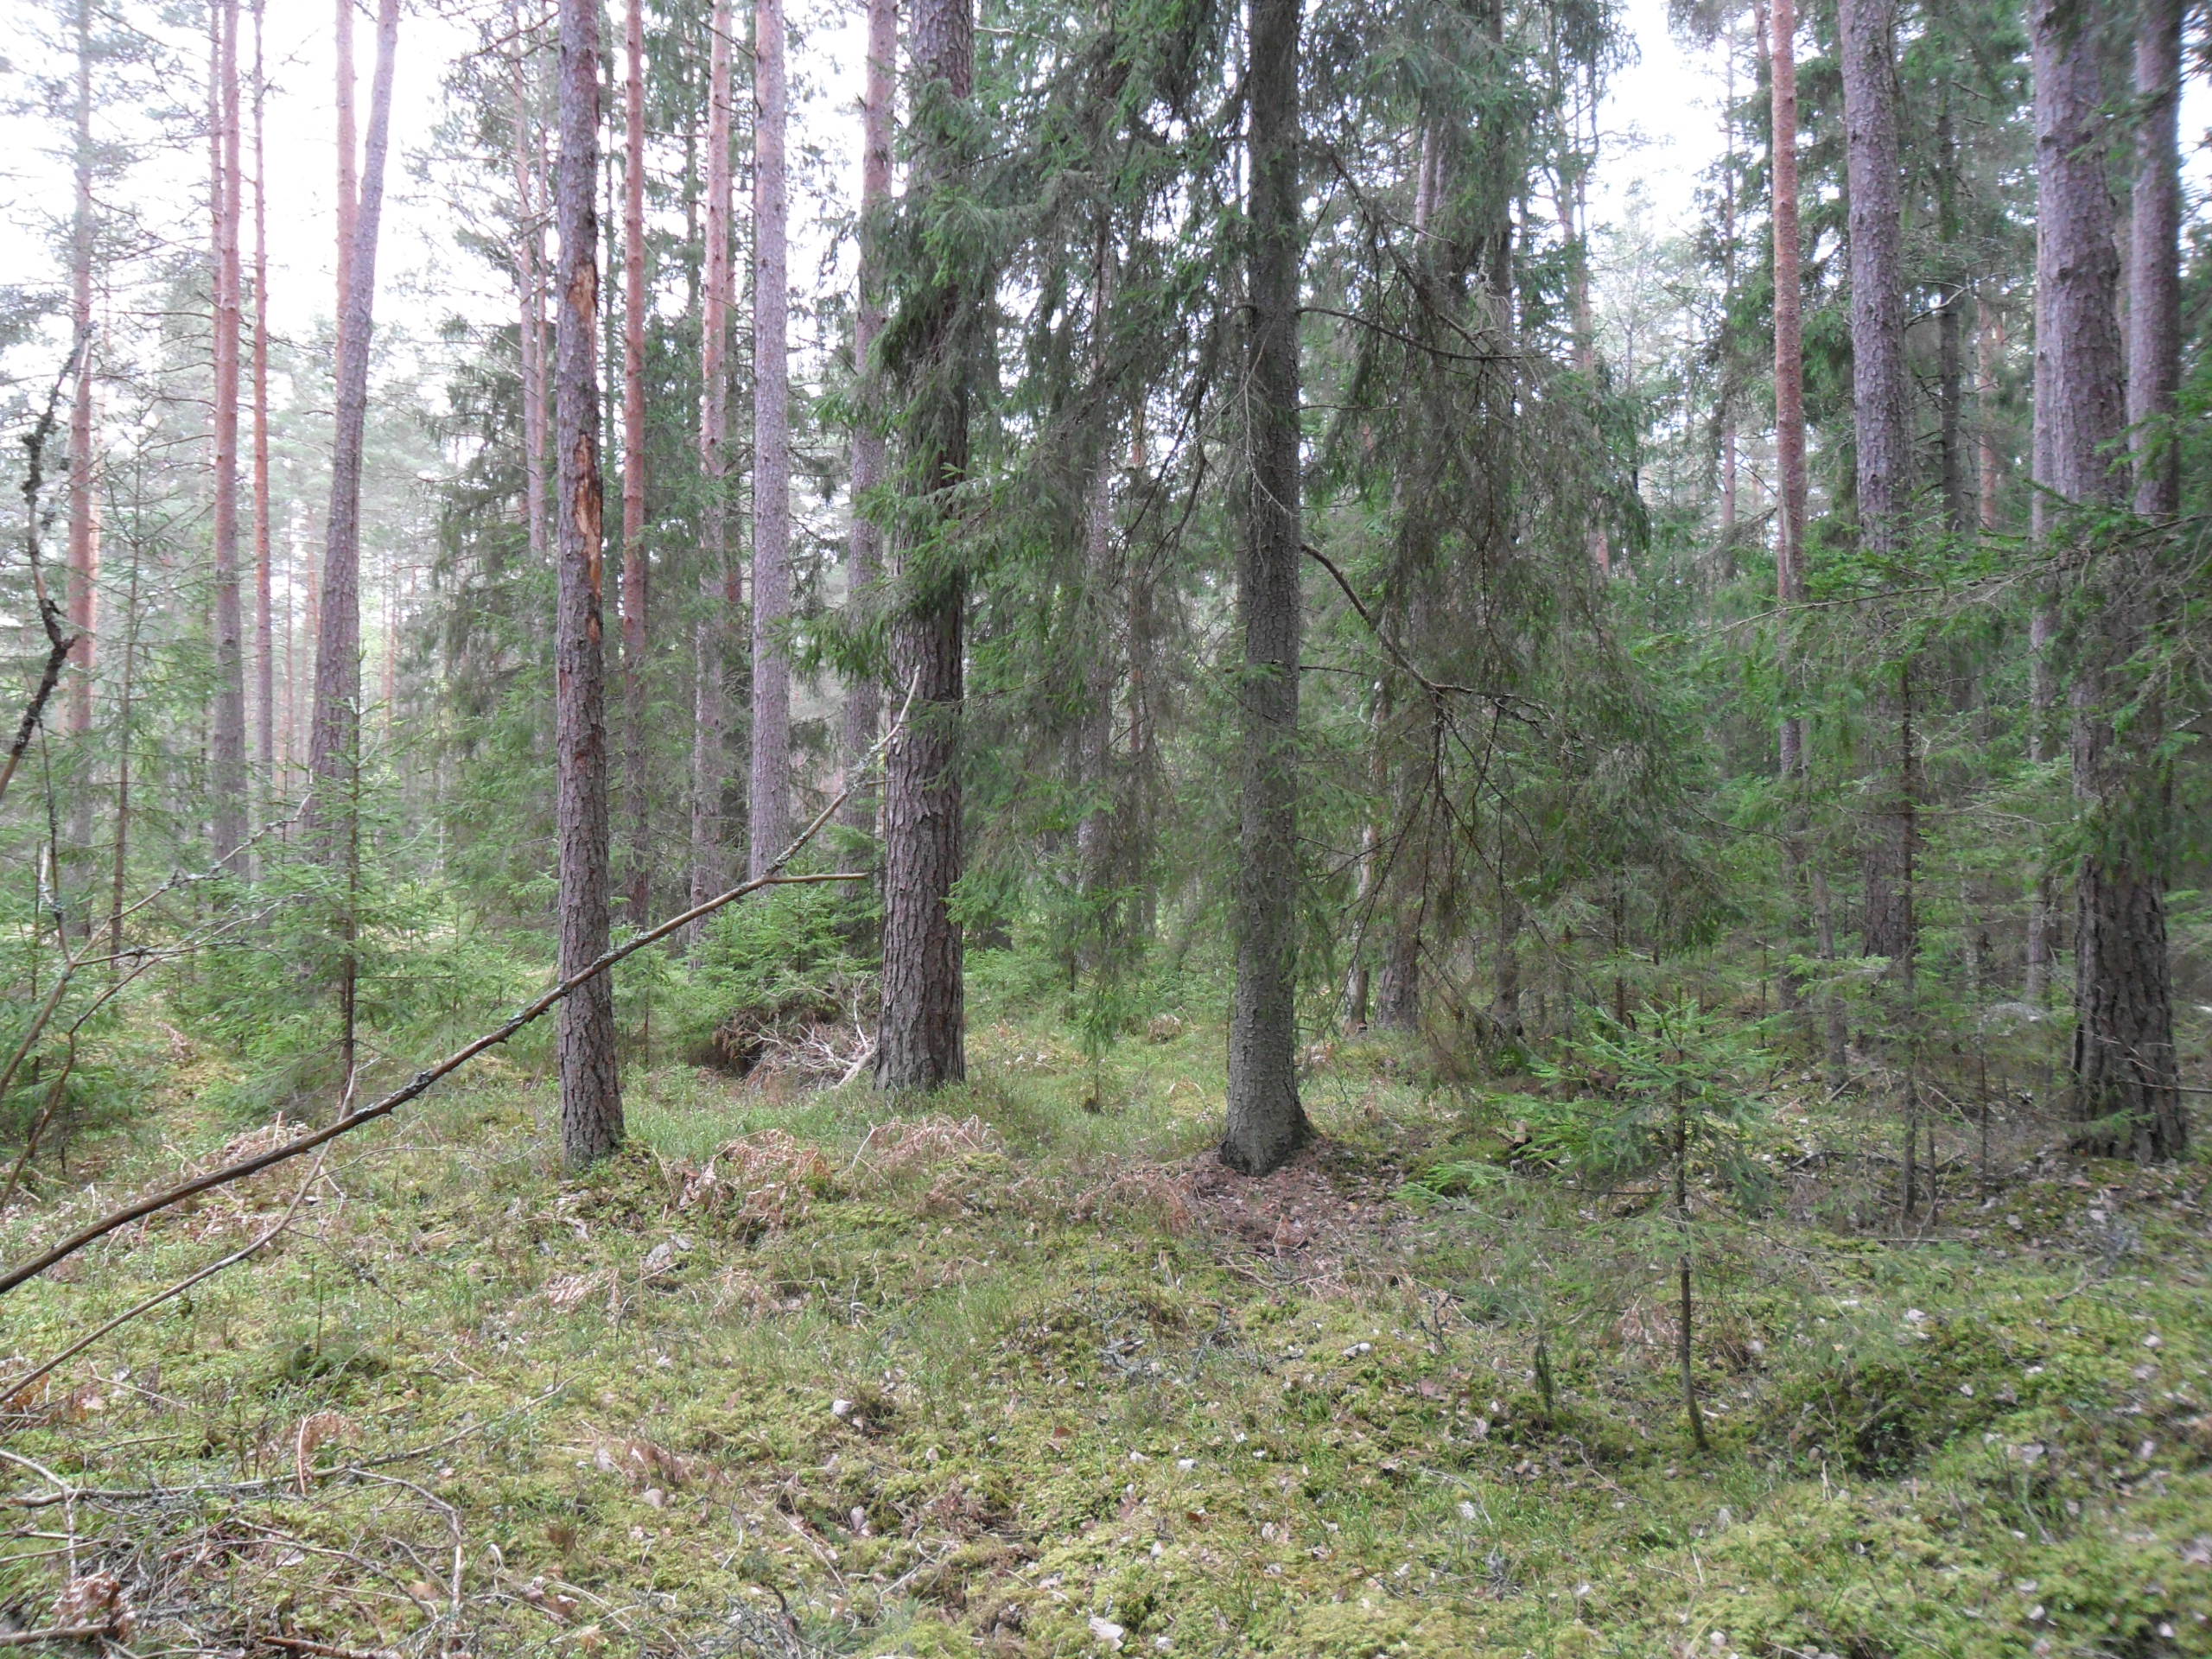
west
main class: Woodland
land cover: Spruce dominated mixed woodland
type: hemiboreal forest and nemoral coniferous forest and mixed broadleaved-coniferous forest
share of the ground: > 75 %
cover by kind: coniferous forest trees 70 %, broadleaved forest trees 30 %
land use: Forestry
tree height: > 5 m
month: May
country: LV
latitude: 57.2231
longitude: 22.9637
